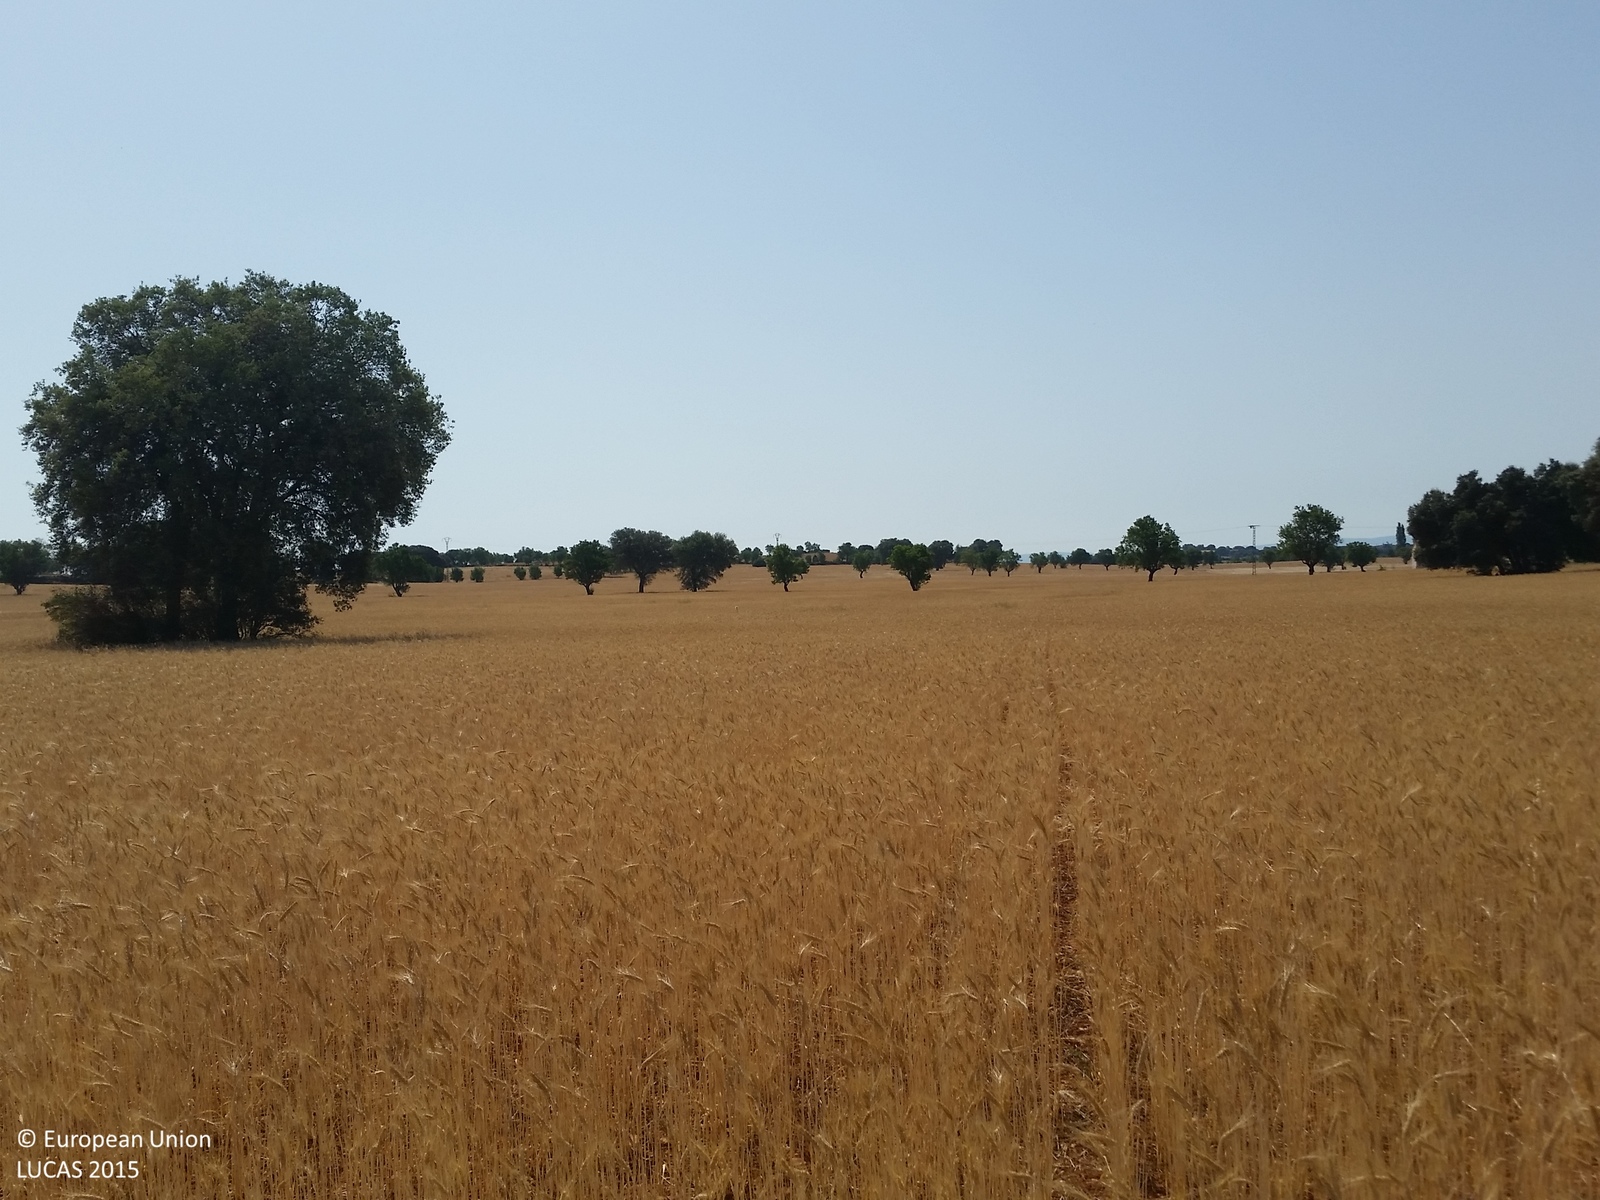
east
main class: Cropland
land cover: Barley
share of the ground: > 75 %
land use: Agriculture (excluding fallow land and kitchen gardens)
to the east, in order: Barley
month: June
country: ES
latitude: 38.7914
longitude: -2.6105
